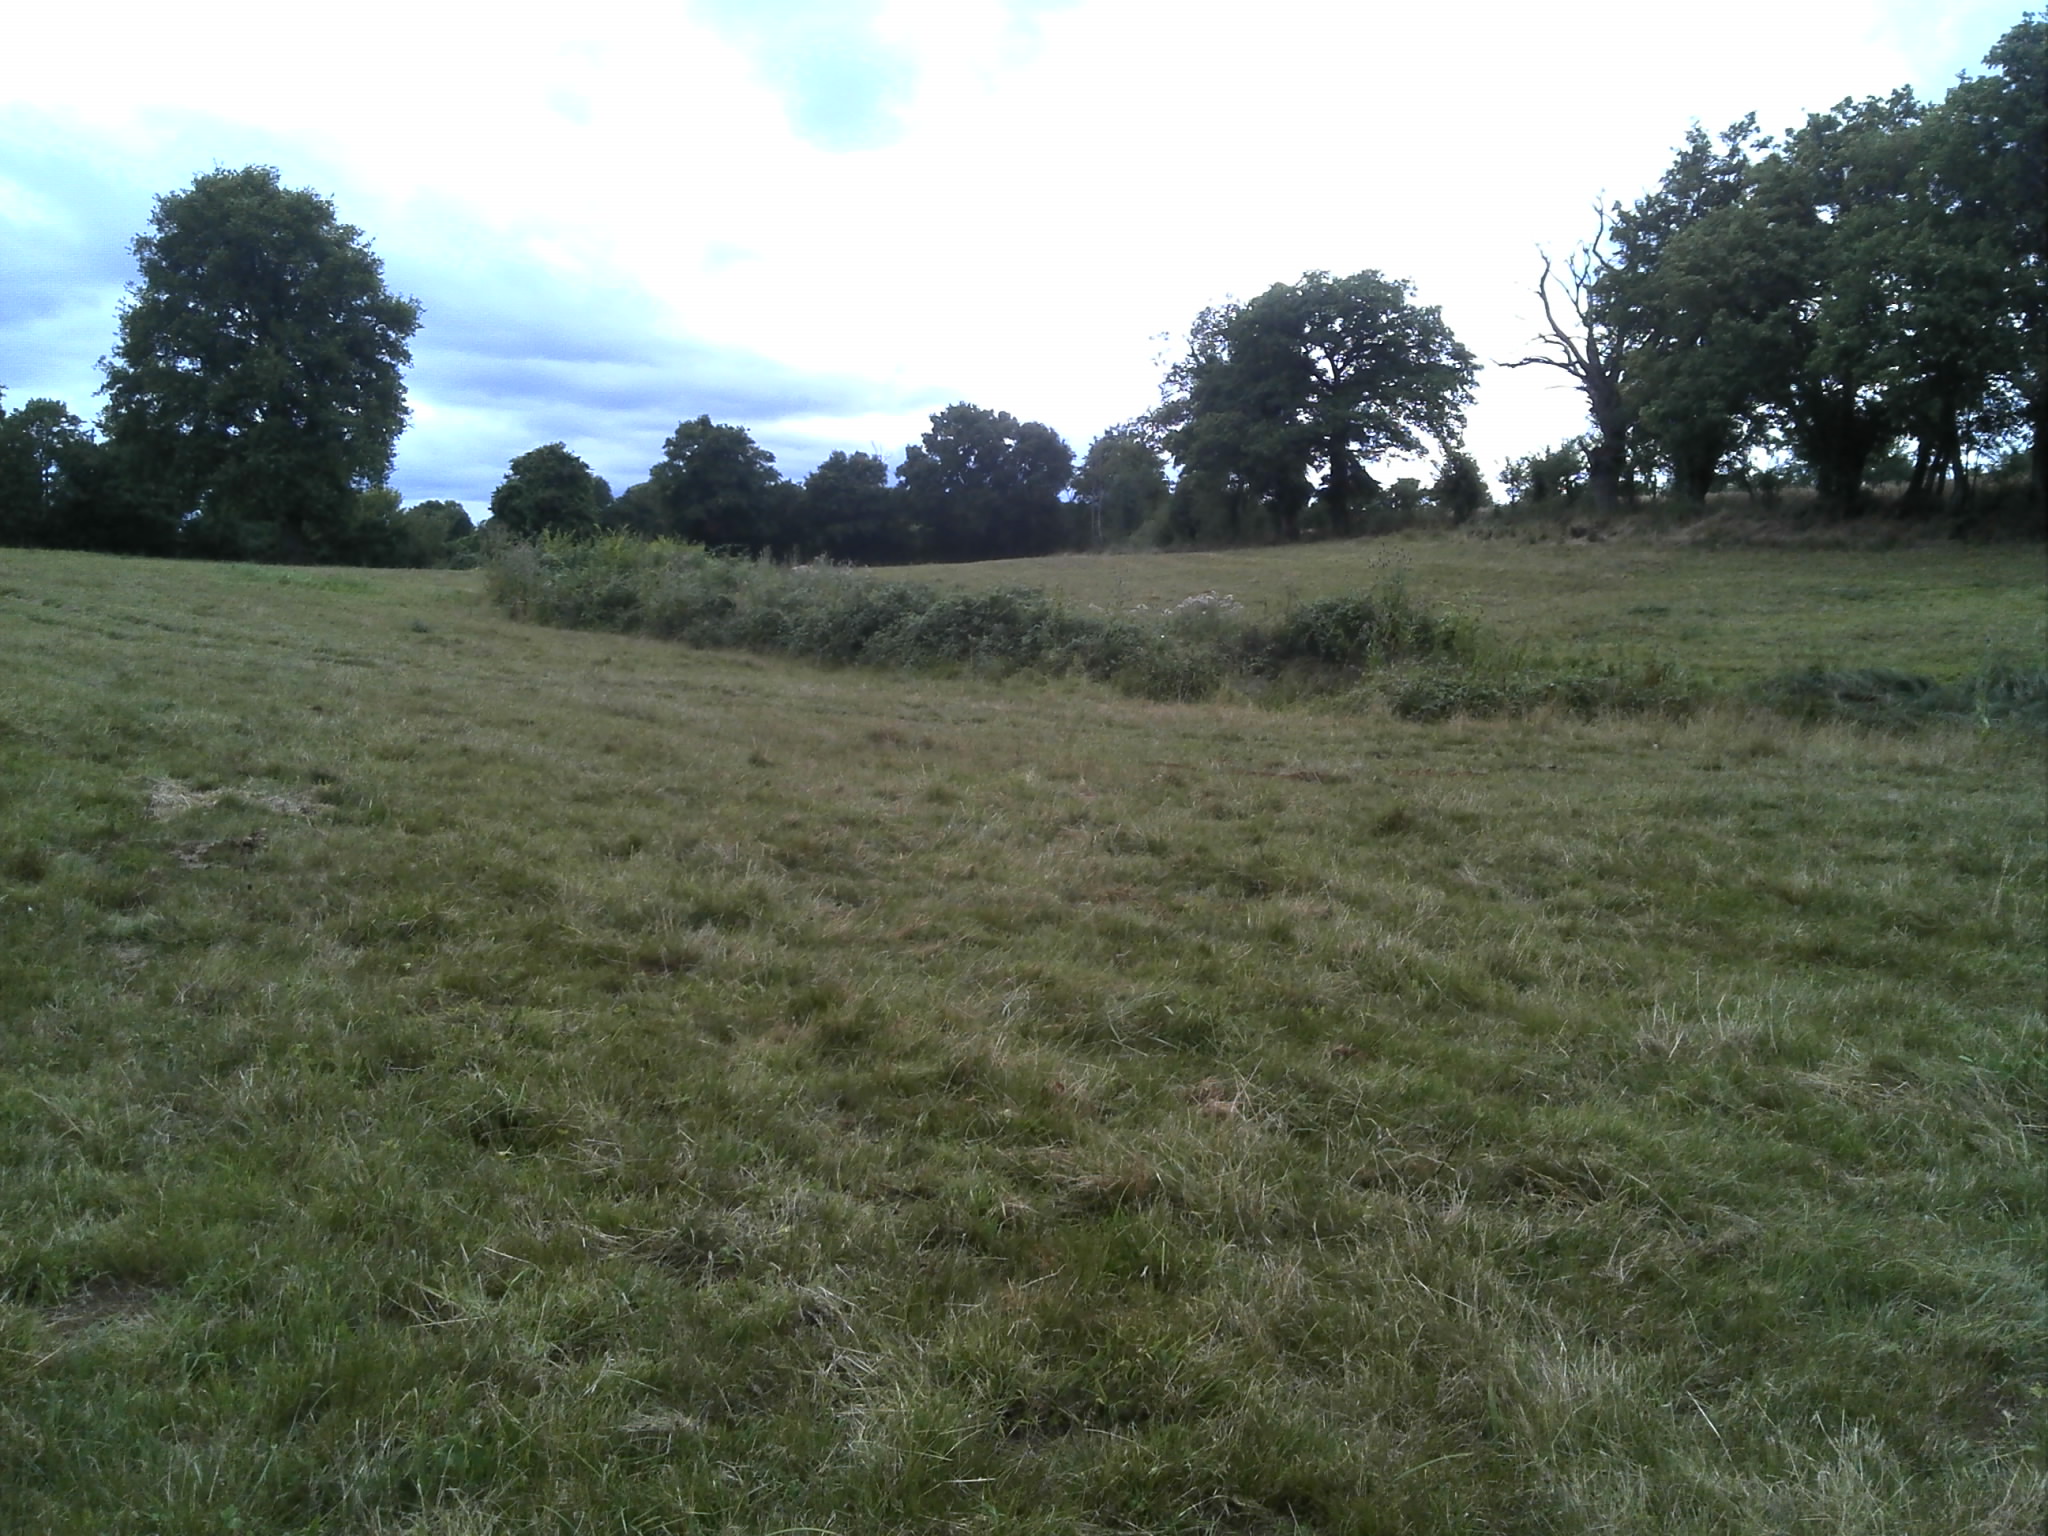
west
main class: Grassland
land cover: Grassland with sparse tree/shrub cover
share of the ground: > 75 %
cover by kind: herbaceous plants 95 %, broadleaved forest trees 5 %
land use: Agriculture (excluding fallow land and kitchen gardens)
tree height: > 5 m
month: July
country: FR
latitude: 46.5217
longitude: 1.5298
